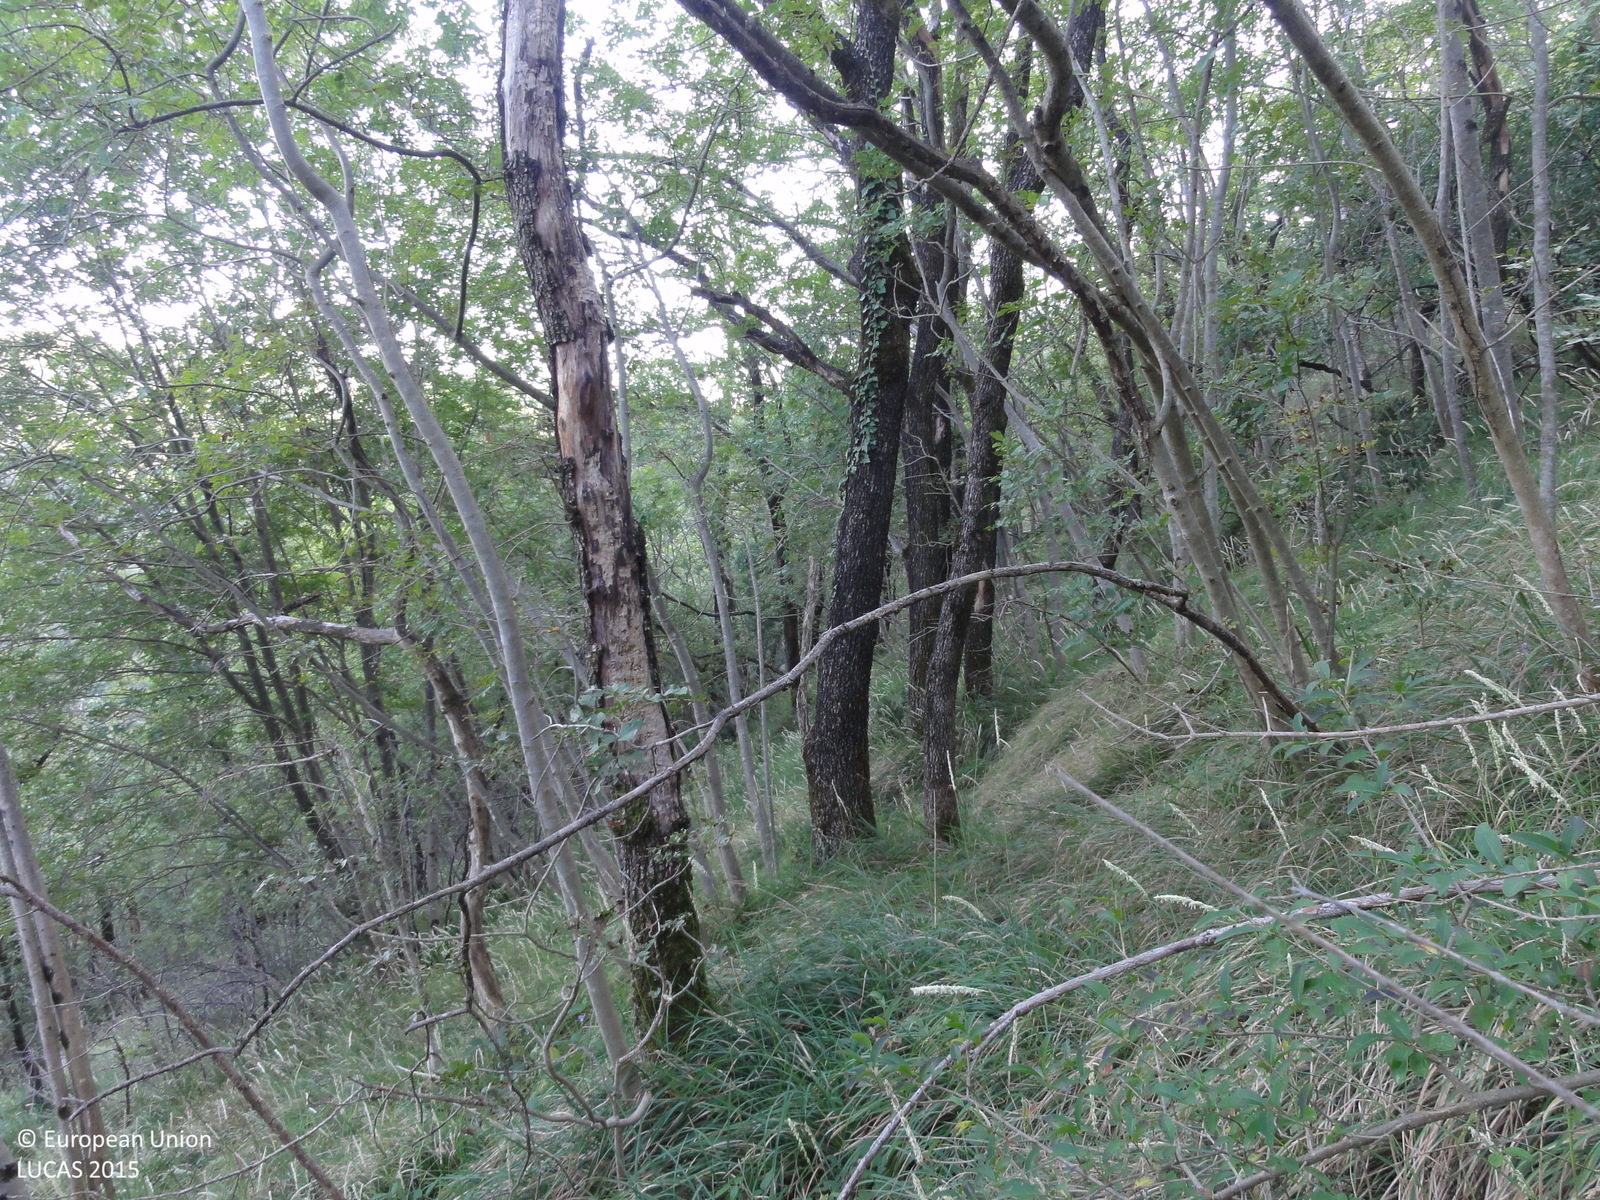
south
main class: Woodland
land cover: Broadleaved woodland
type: thermophilous deciduous forest
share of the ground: > 75 %
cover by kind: broadleaved forest trees 80 %, herbaceous plants 15 %, shrubs 5 %
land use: Semi-natural and natural areas not in use
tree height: > 5 m
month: August
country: SI
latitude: 46.0202
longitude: 13.6001
